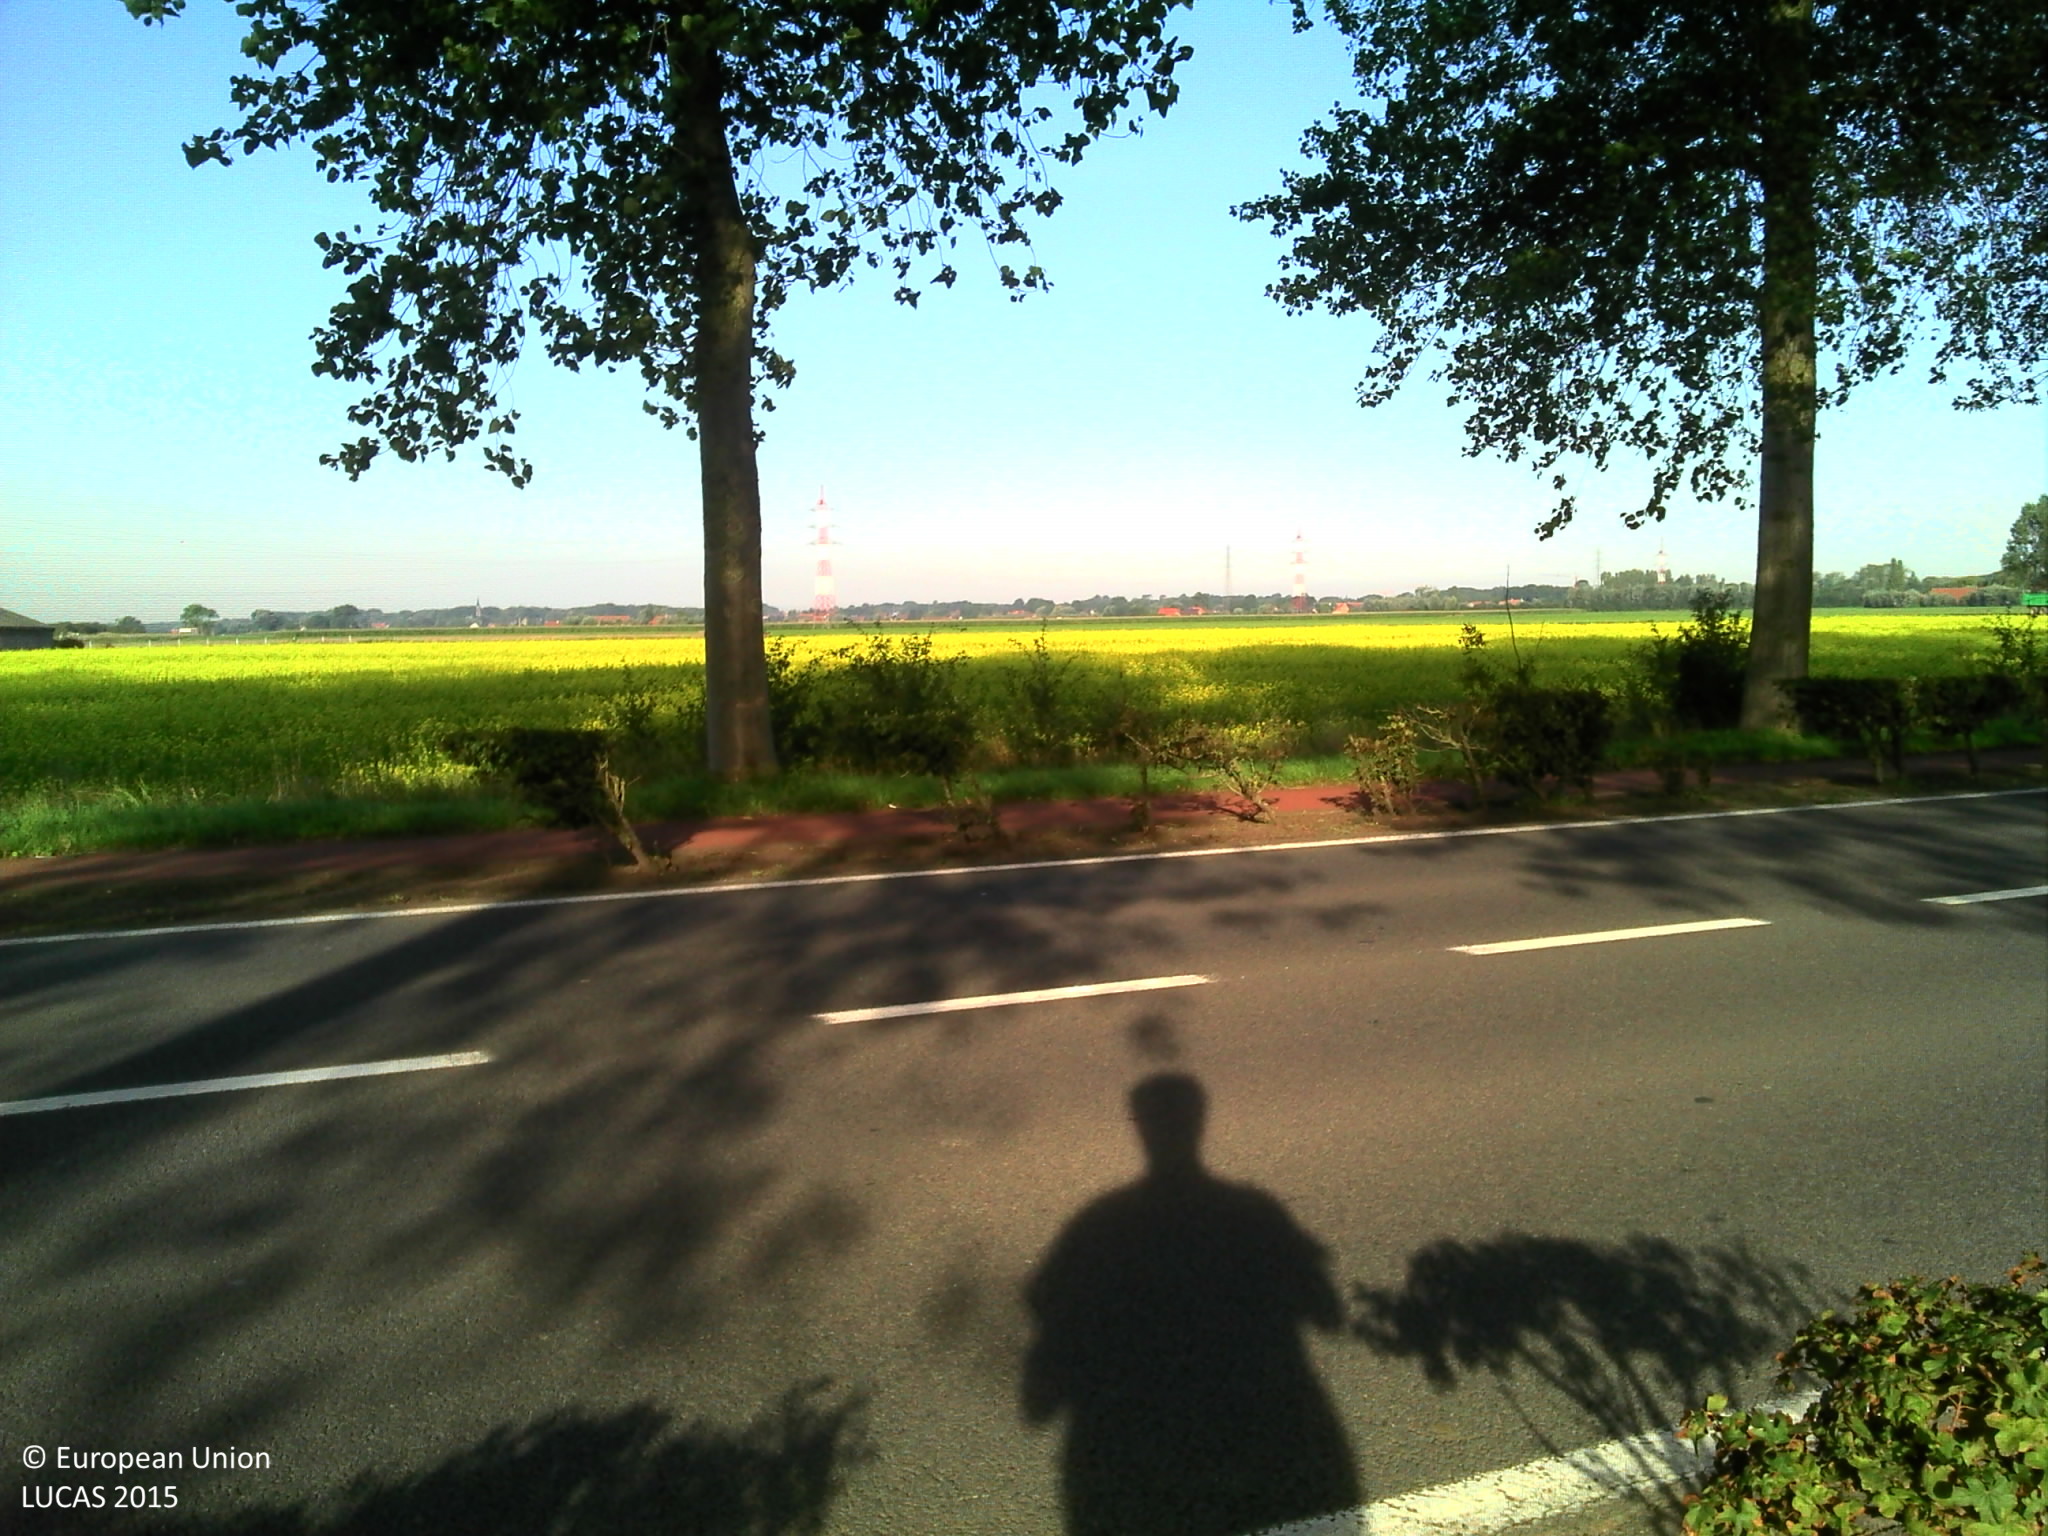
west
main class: Woodland
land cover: Broadleaved woodland
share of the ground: > 75 %
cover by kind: broadleaved forest trees 80 %, herbaceous plants 20 %
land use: Road transport
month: September
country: BE
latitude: 51.1050
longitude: 2.6901
